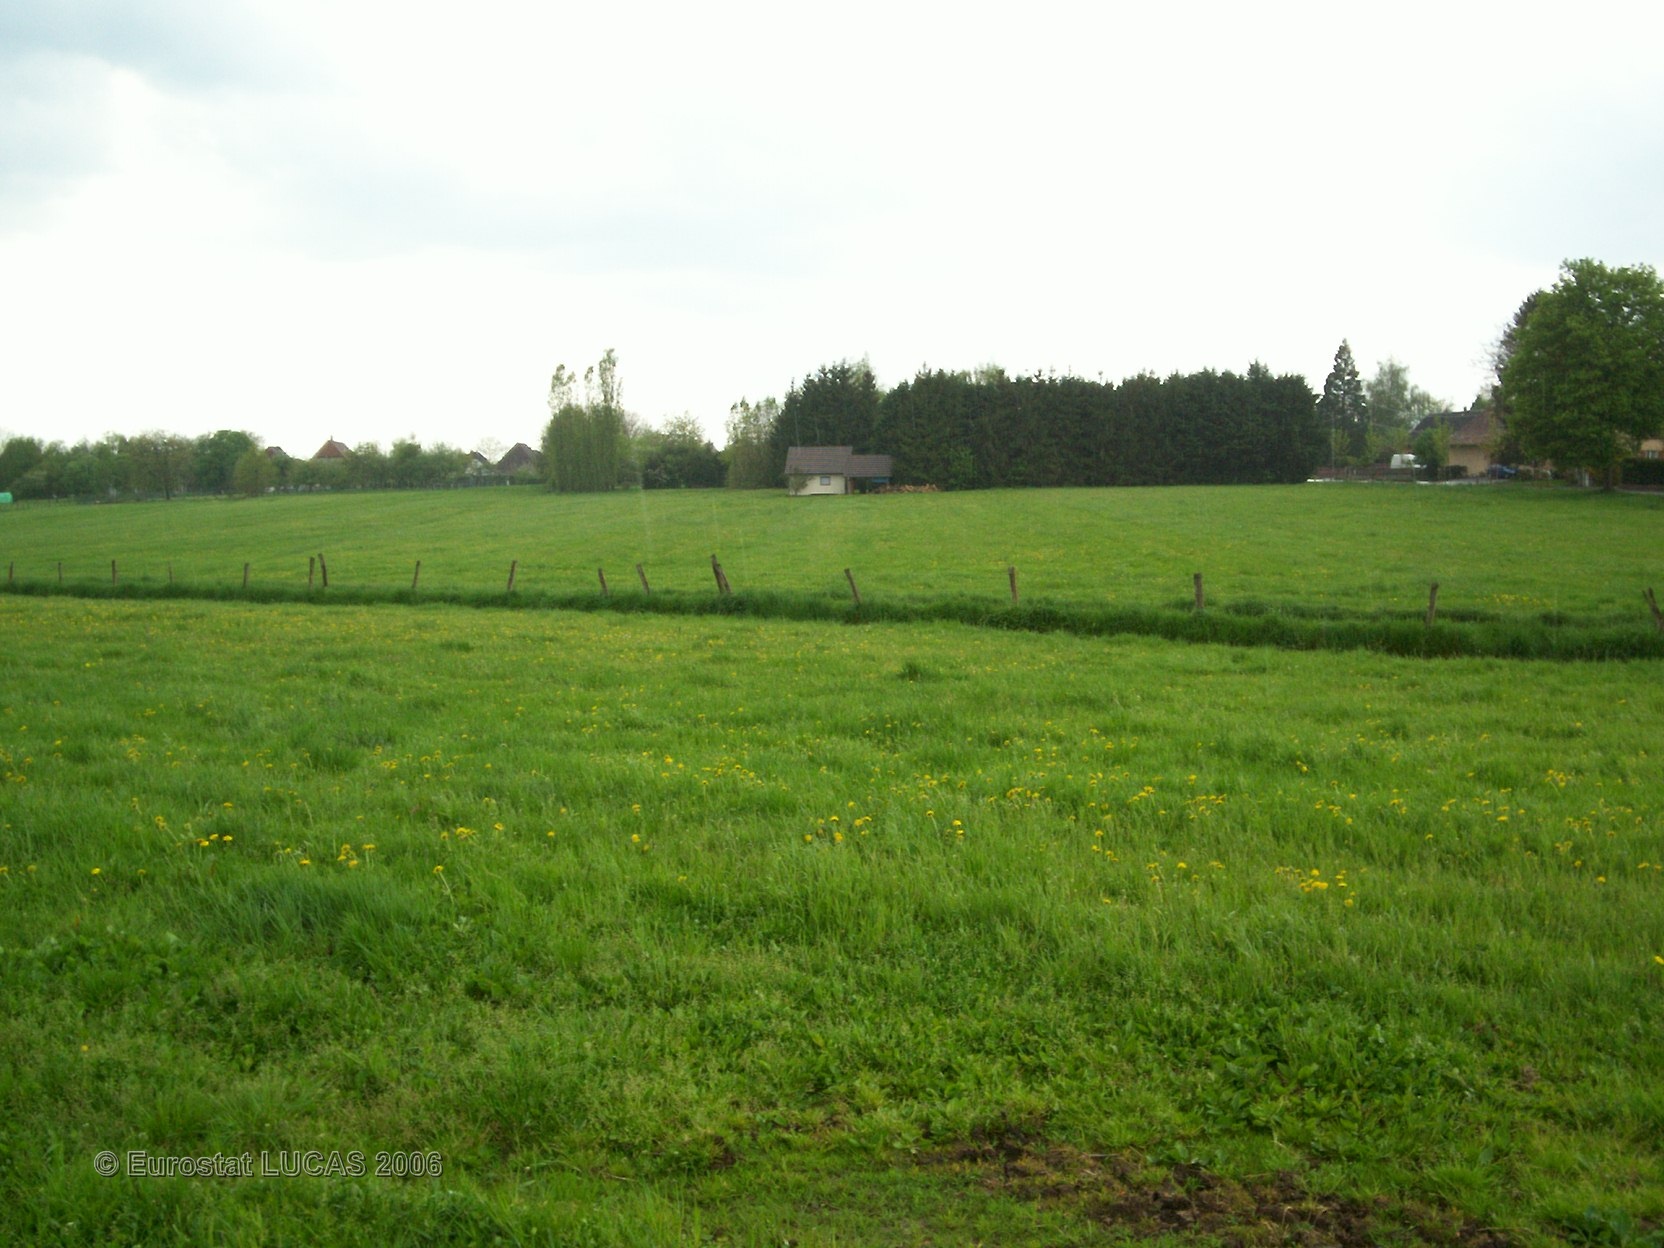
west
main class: Grassland
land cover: Grassland without tree/shrub cover
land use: Agriculture (excluding fallow land and kitchen gardens)
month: May
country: FR
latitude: 47.6606
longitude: 7.0055
